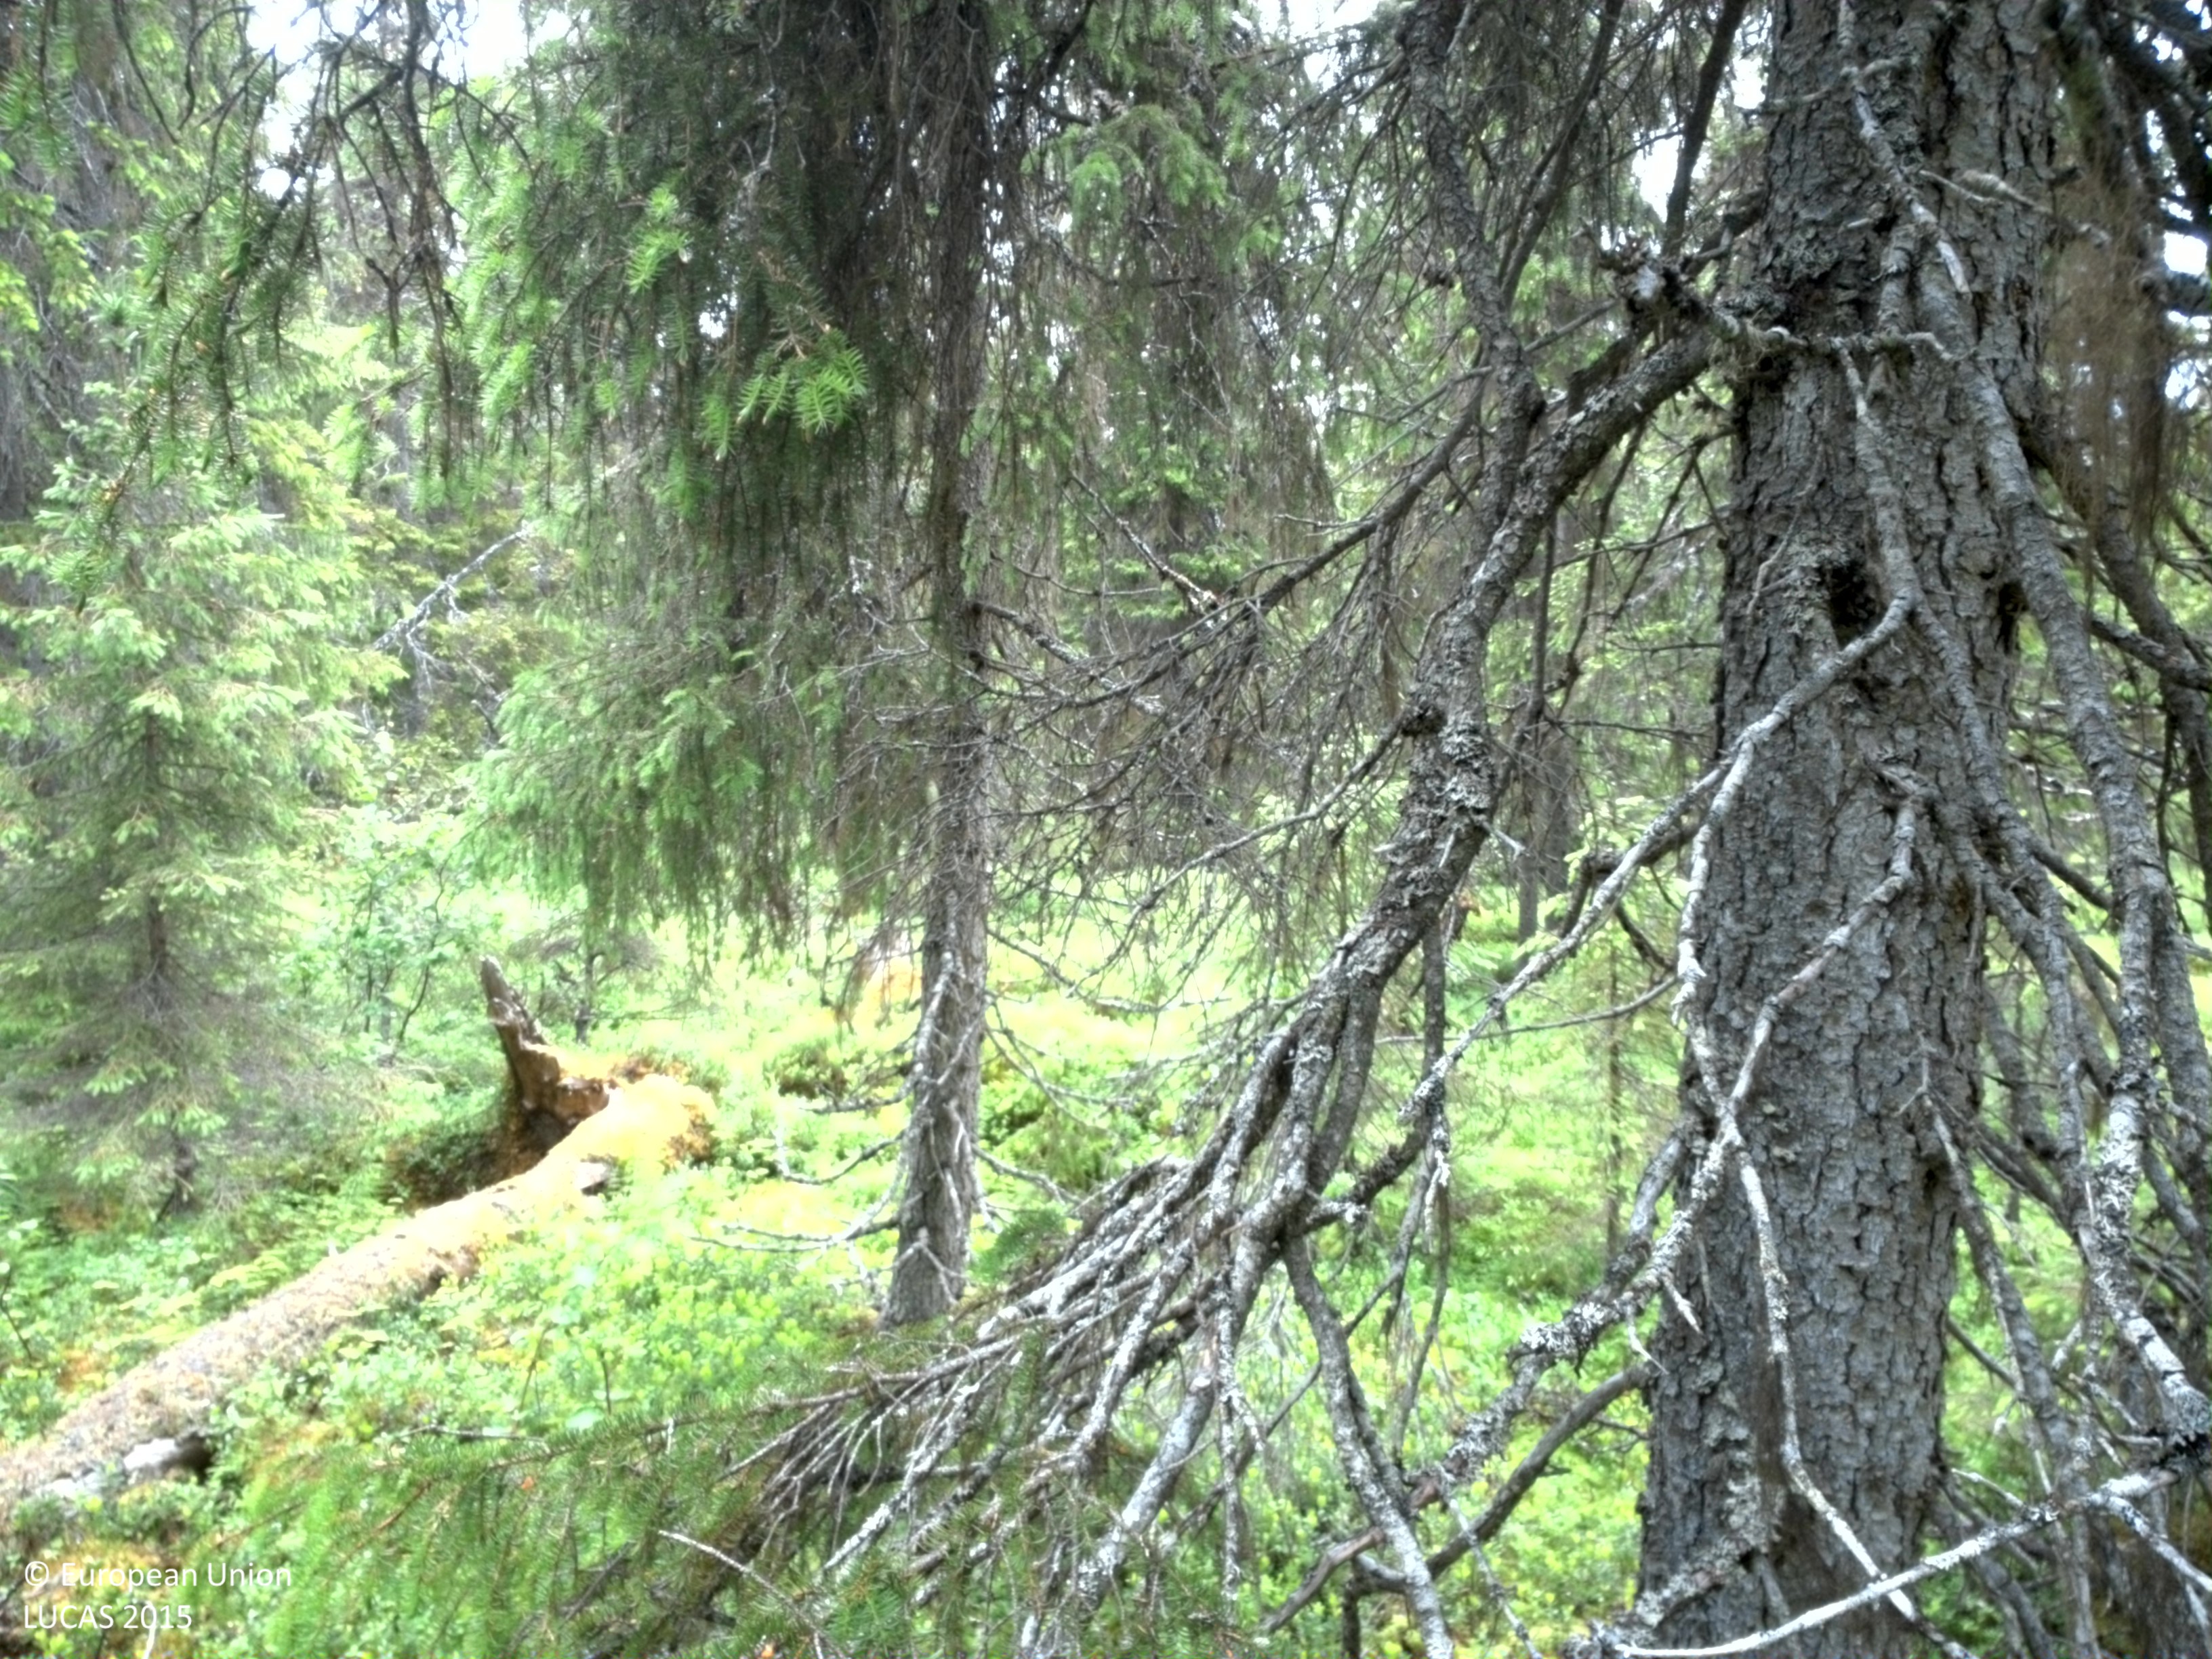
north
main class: Woodland
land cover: Spruce dominated coniferous woodland
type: boreal forest
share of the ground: 25 - 50 %
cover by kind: shrubs 45 %, coniferous forest trees 40 %, lichens and mosses 10 %, herbaceous plants 5 %
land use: Forestry
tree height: > 5 m
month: July
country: SE
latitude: 65.5128
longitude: 15.6075
